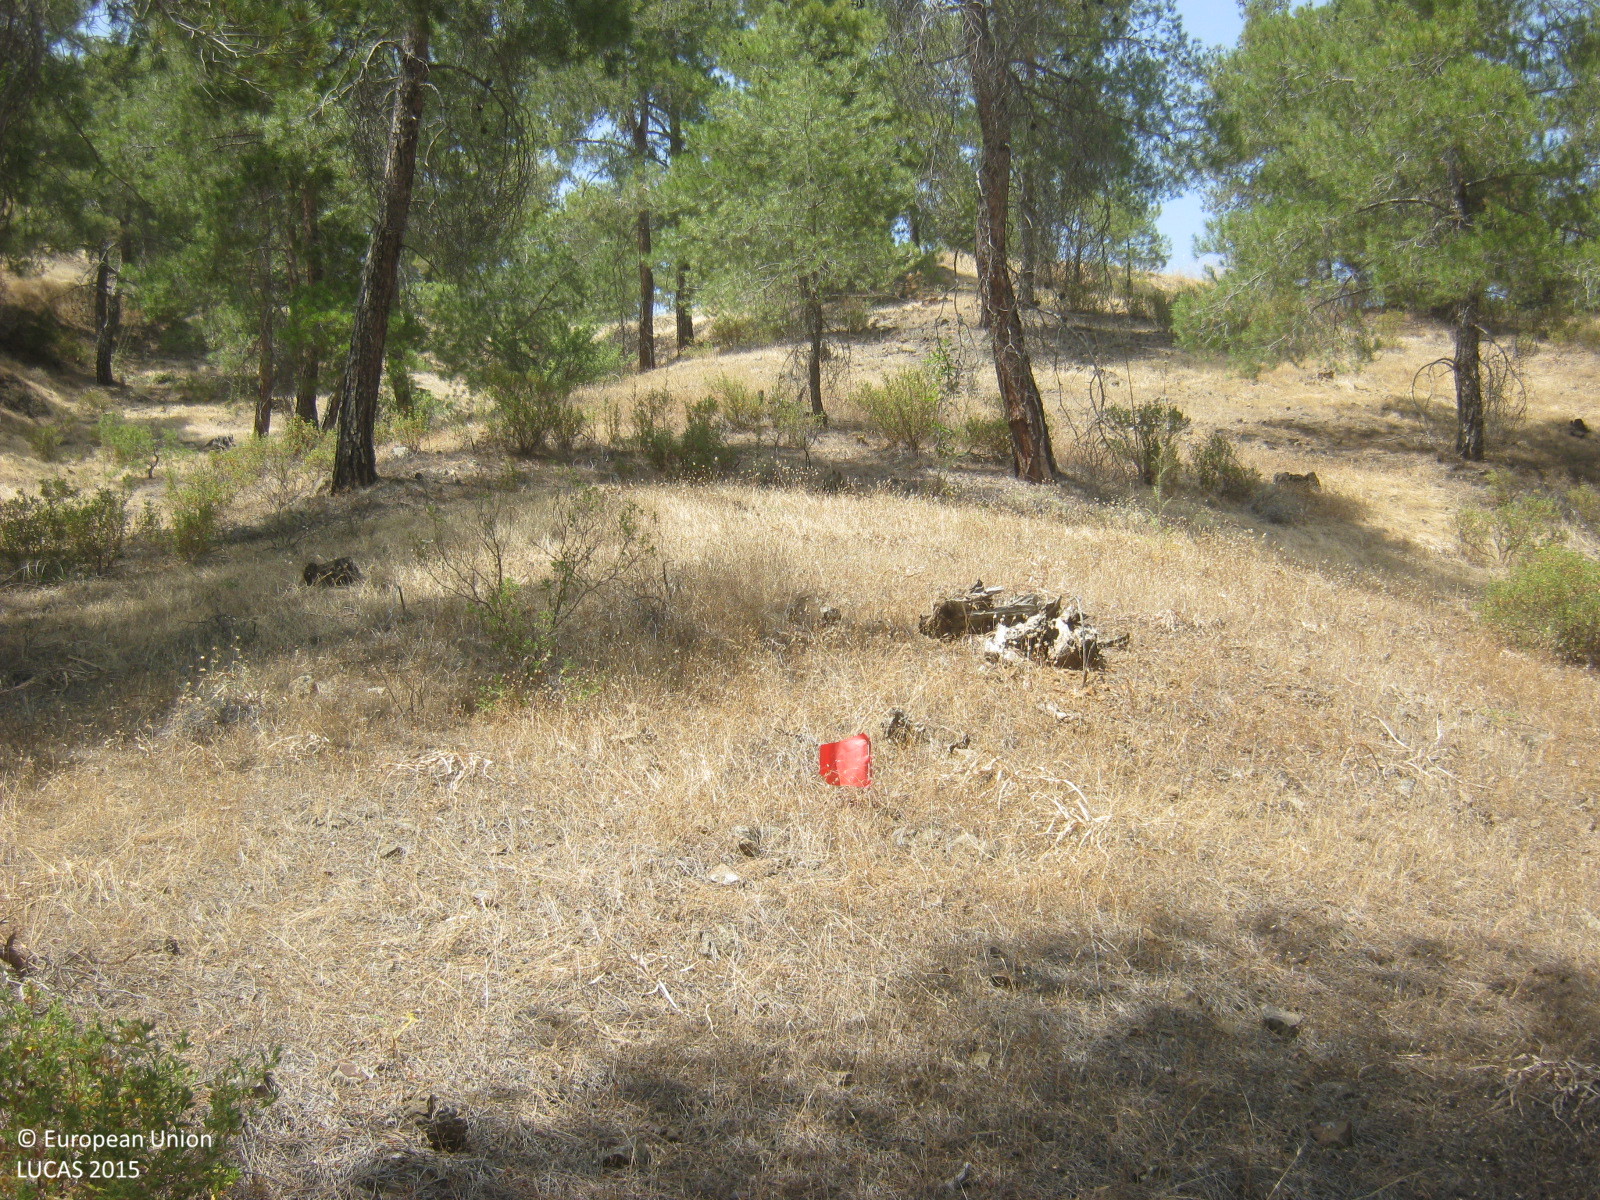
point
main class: Woodland
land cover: Pine dominated coniferous woodland
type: coniferous forest of the mediterranean region
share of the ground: 50 - 75 %
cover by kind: coniferous forest trees 60 %, herbaceous plants 20 %, shrubs 10 %, unconsolidated bare surface 10 %
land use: Forestry
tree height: > 5 m
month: June
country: CY
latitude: 34.9968
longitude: 33.0868
